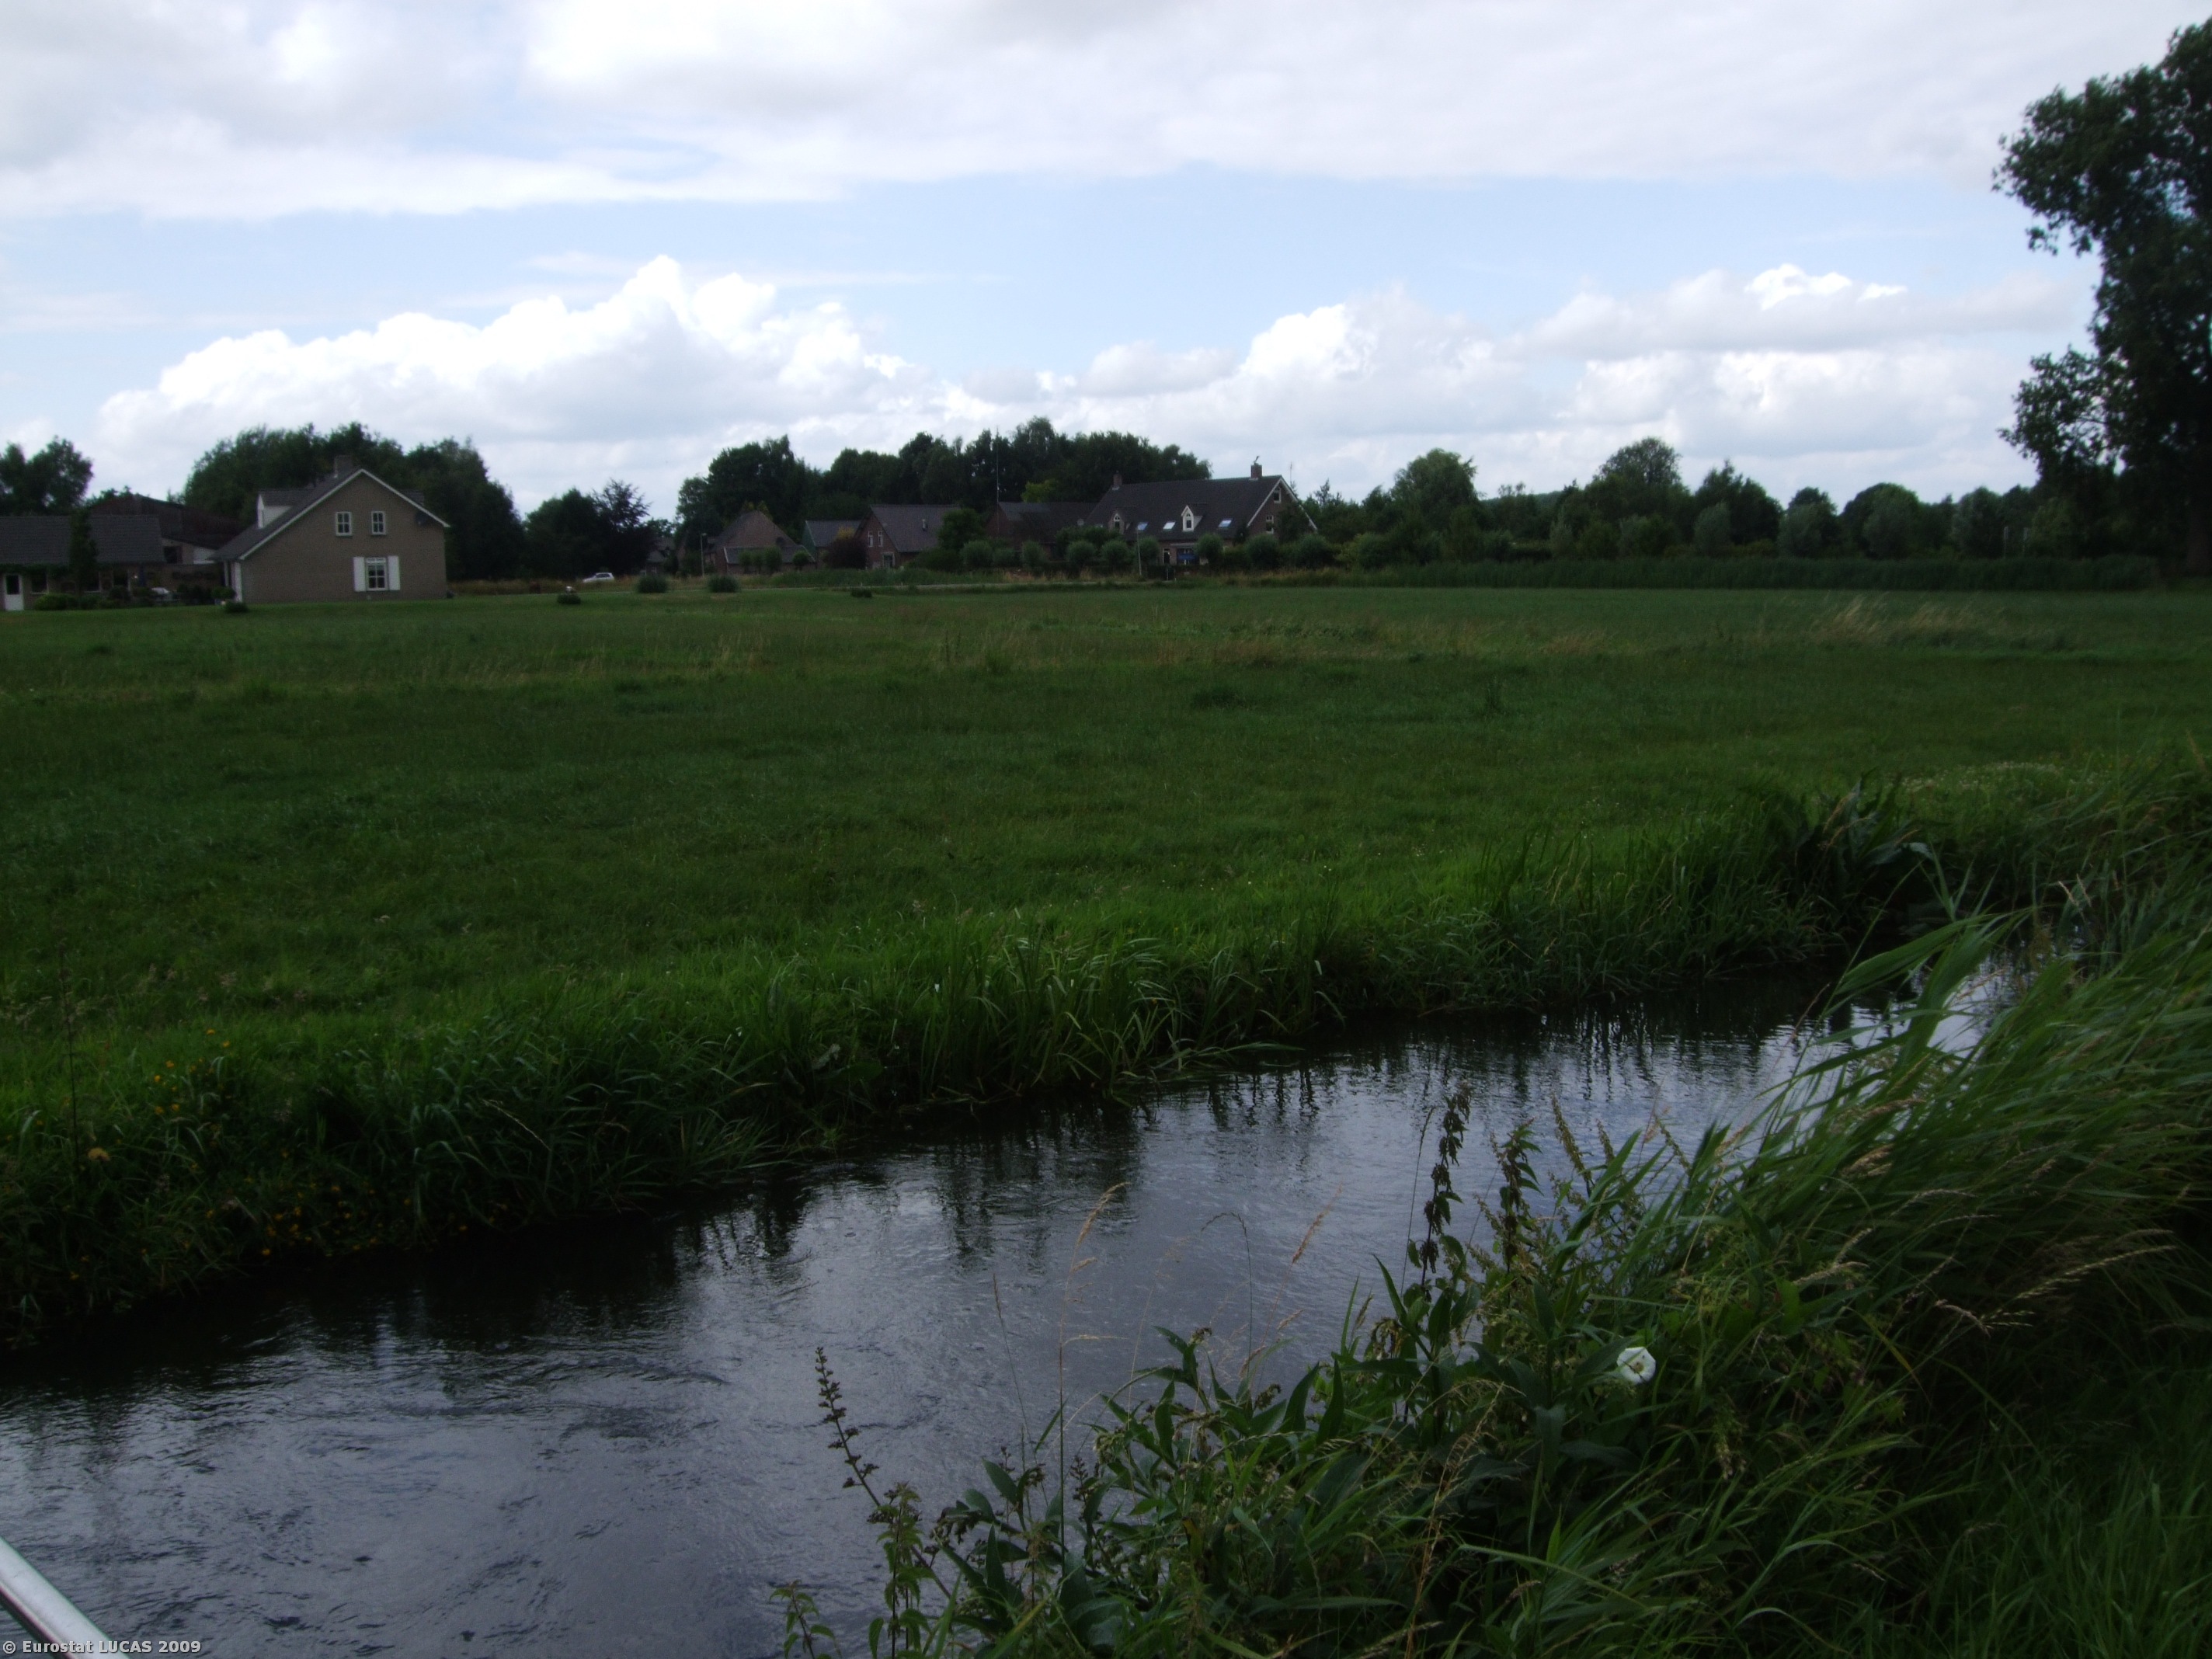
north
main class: Grassland
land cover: Grassland without tree/shrub cover
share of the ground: > 75 %
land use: Agriculture (excluding fallow land and kitchen gardens)
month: July
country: NL
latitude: 51.3371
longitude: 5.4765
